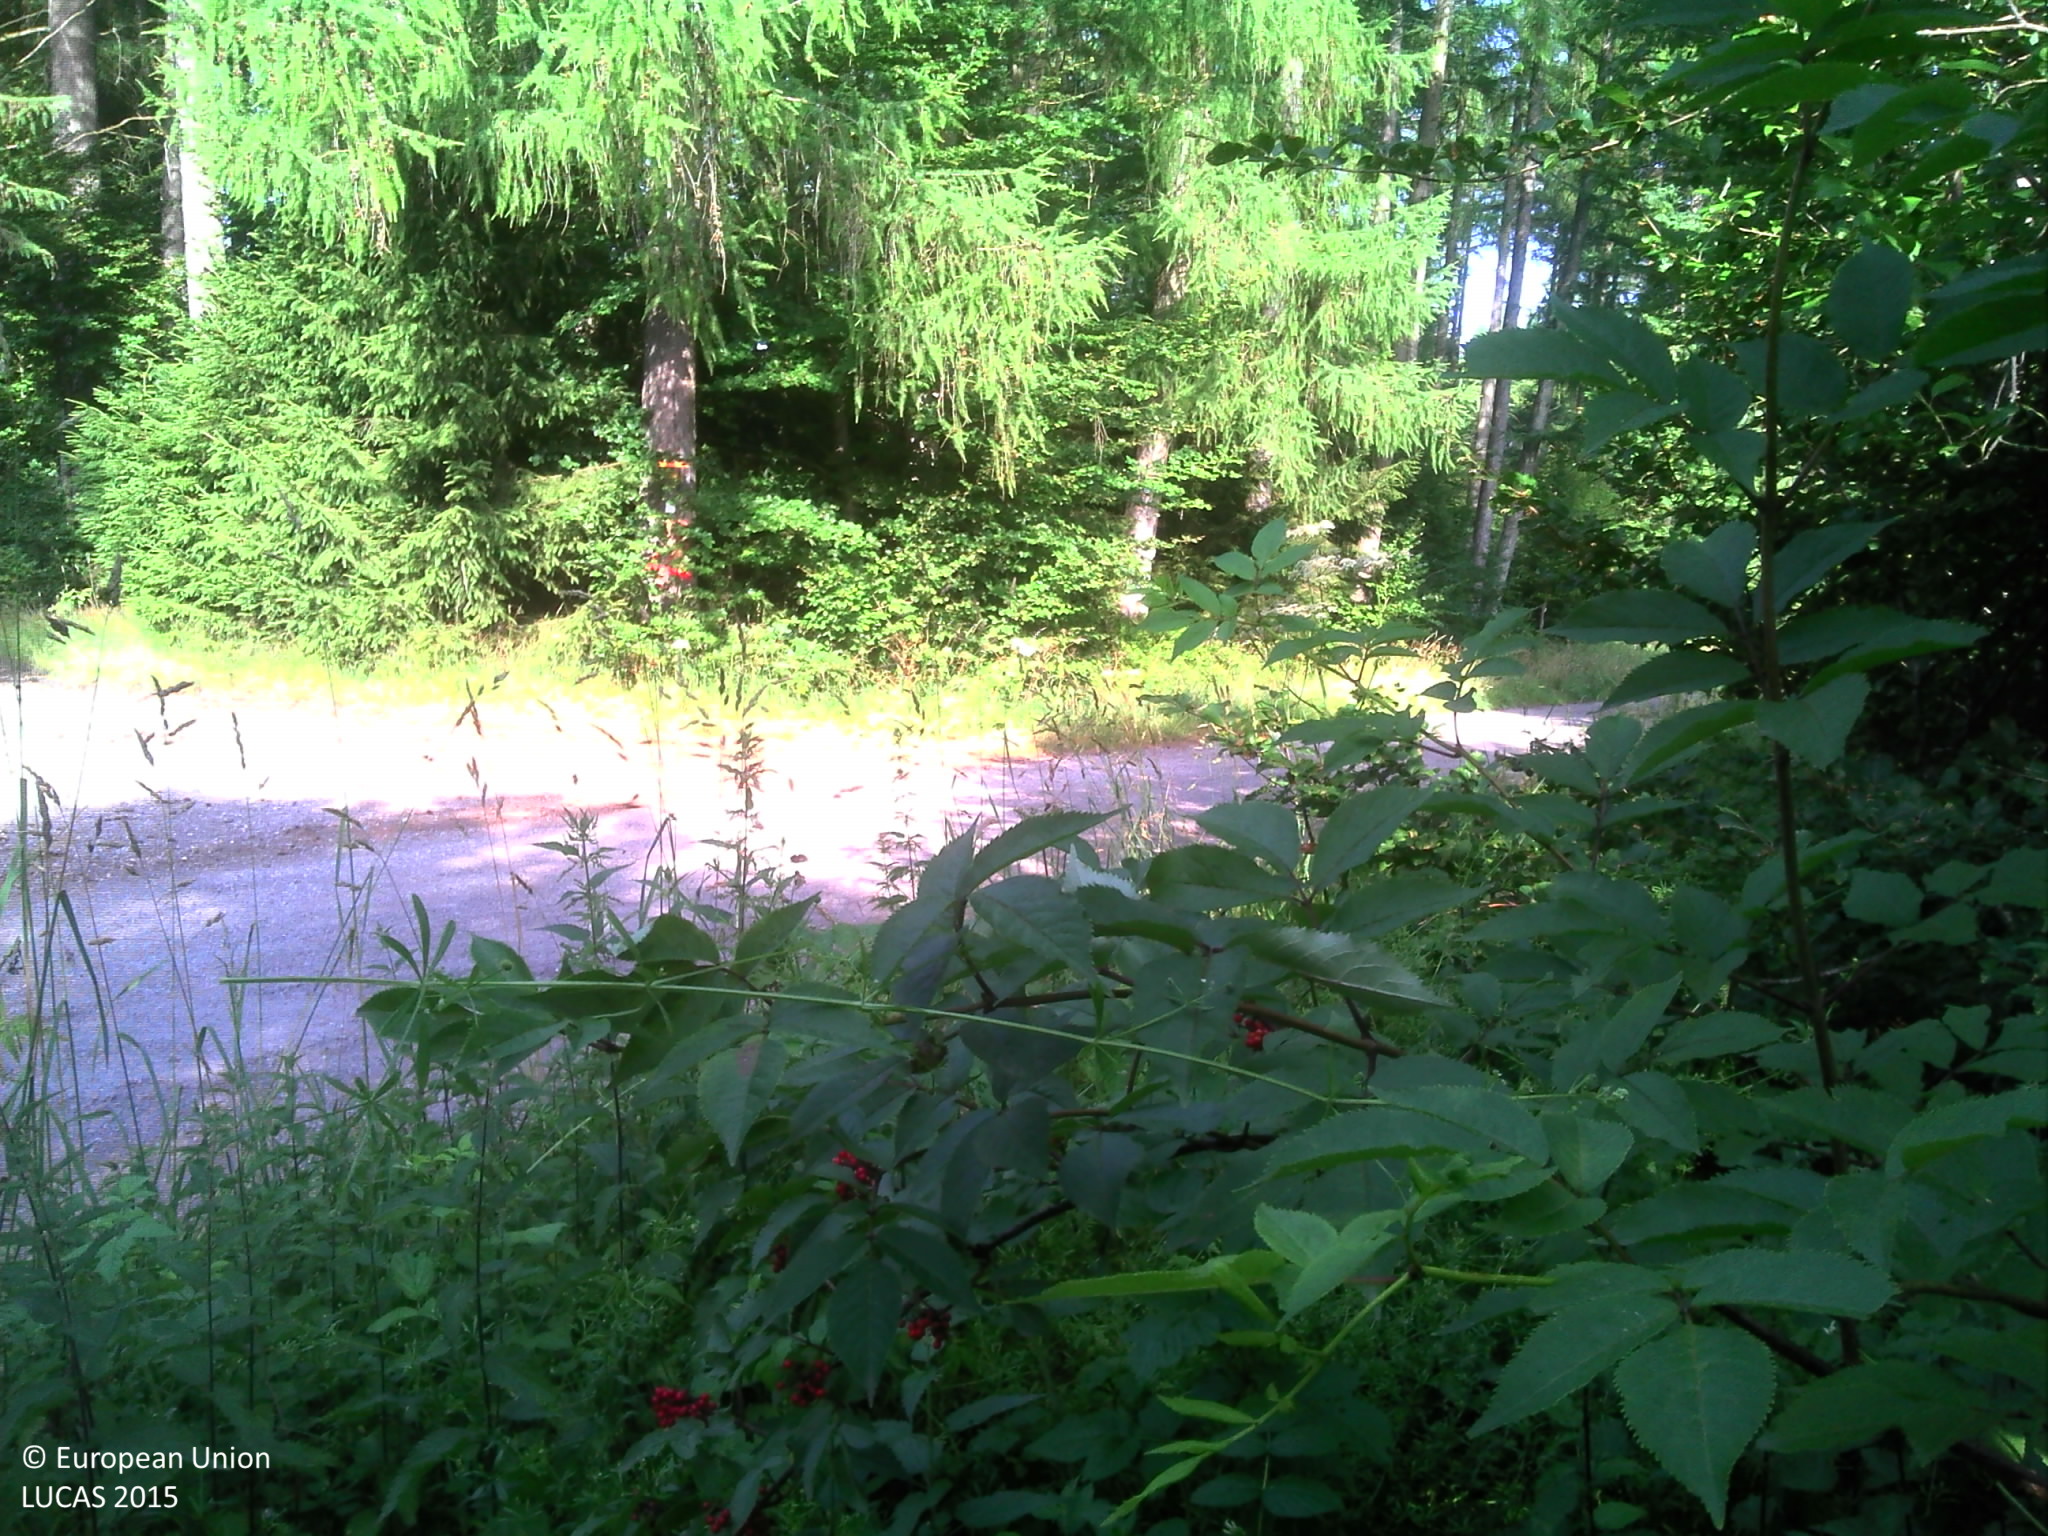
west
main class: Woodland
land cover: Broadleaved woodland
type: acidophilous oak and oak-birch forest
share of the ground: > 75 %
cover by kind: broadleaved forest trees 80 %, herbaceous plants 15 %, shrubs 5 %
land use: Forestry
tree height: > 5 m
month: July
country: BE
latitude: 49.9355
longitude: 5.5540
